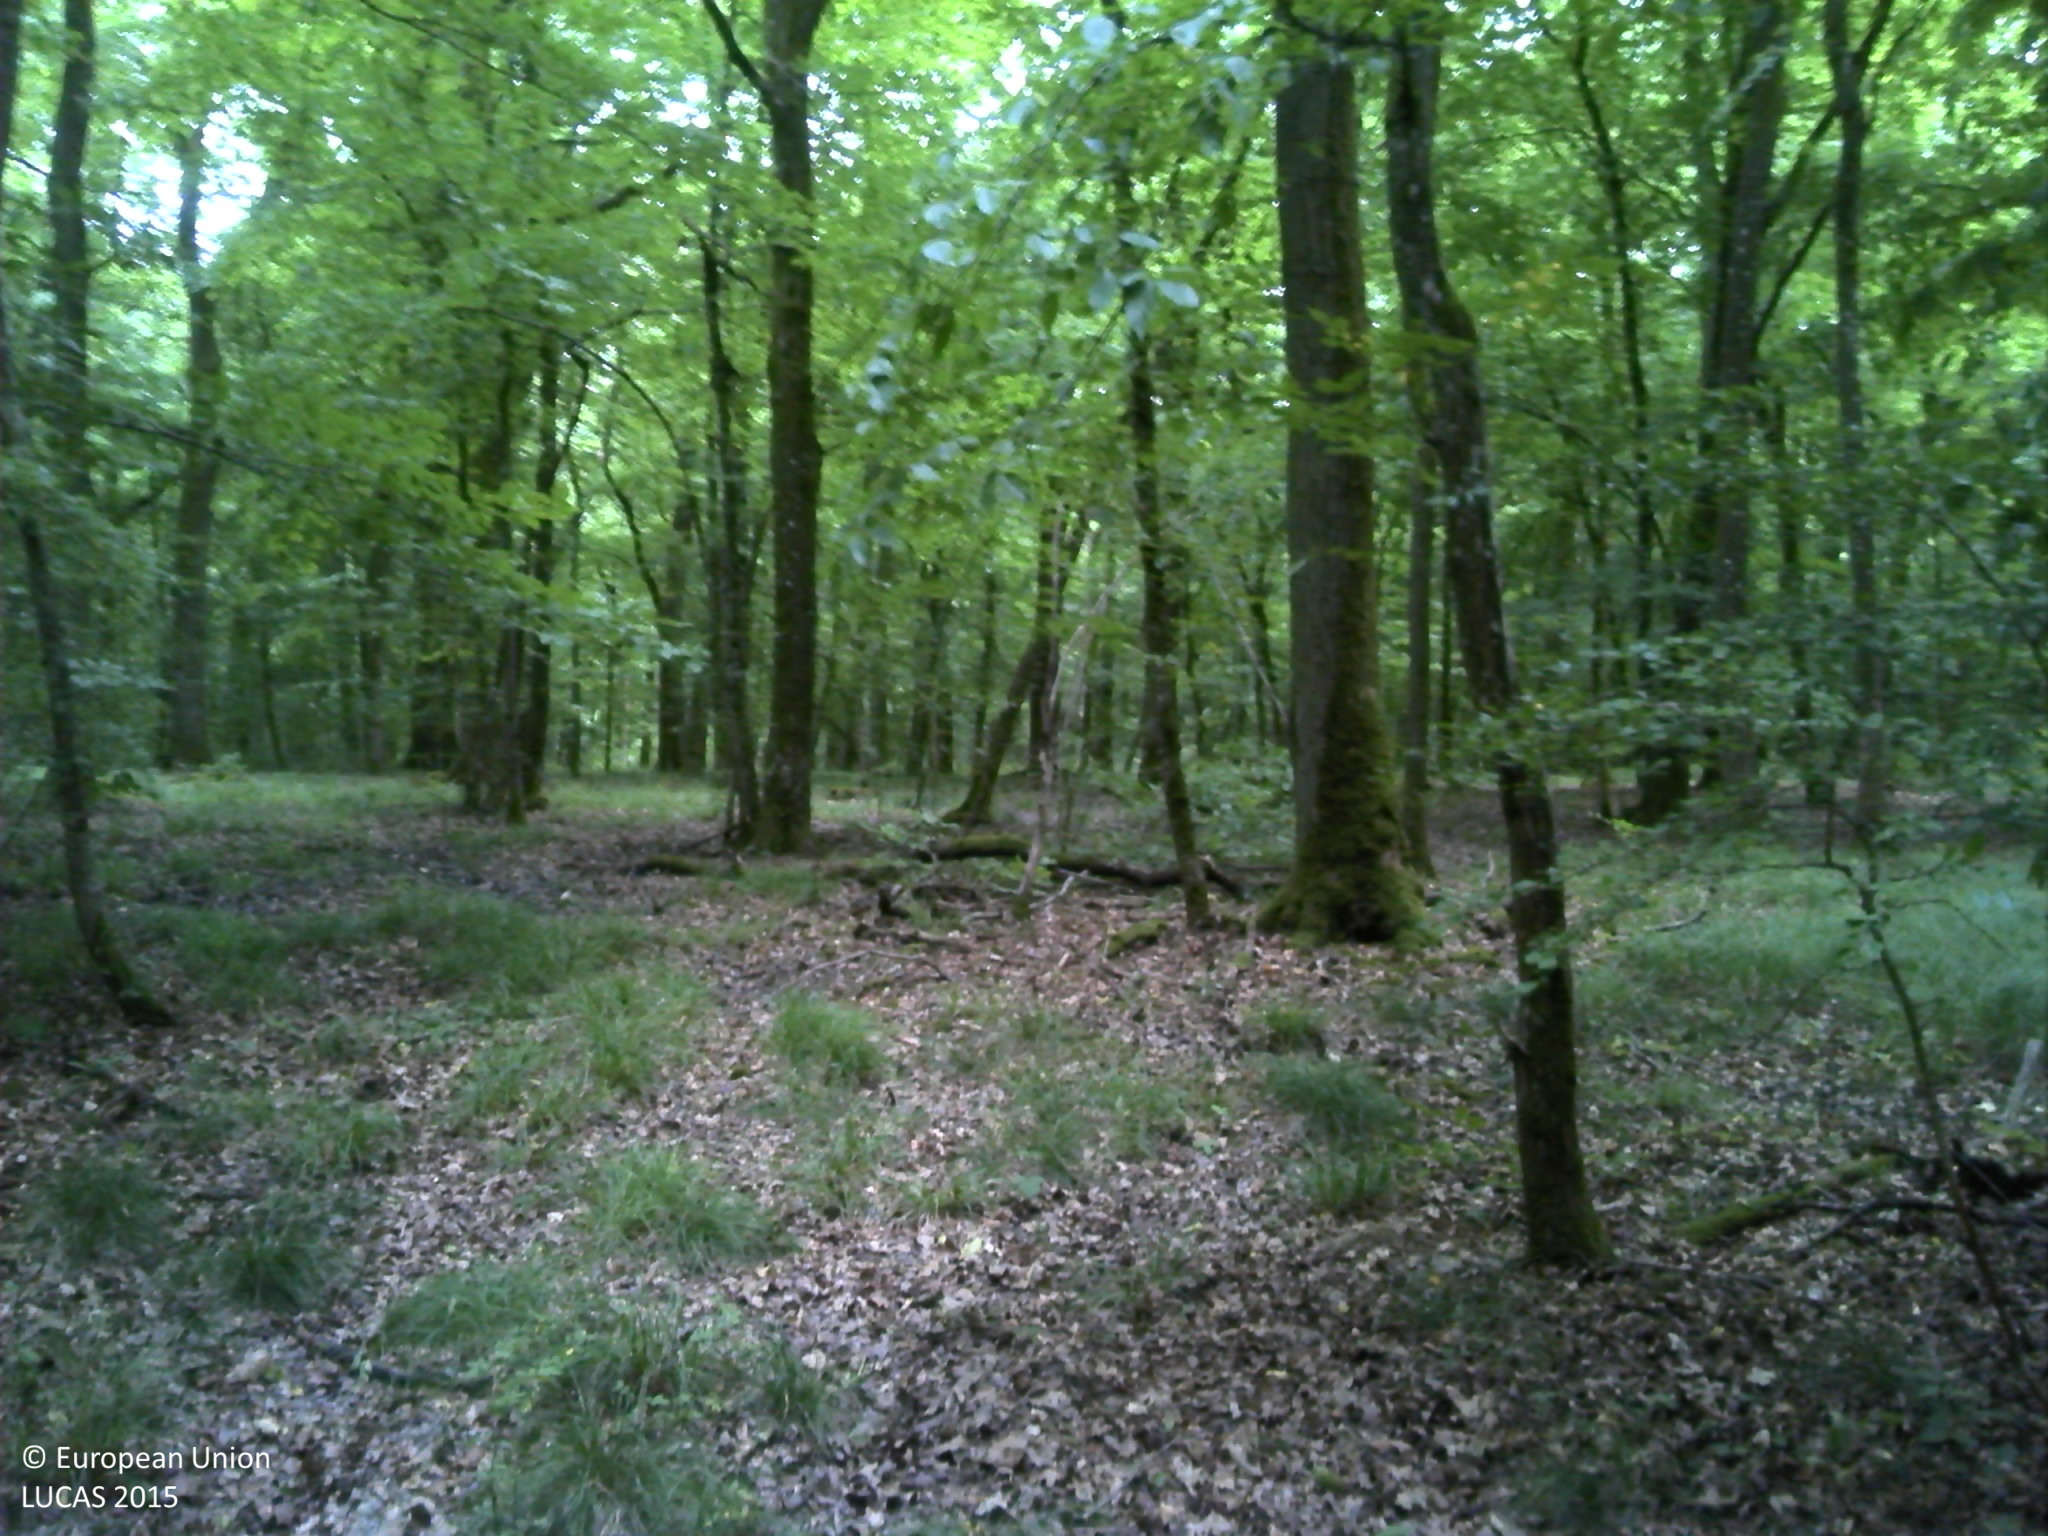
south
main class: Woodland
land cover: Broadleaved woodland
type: mesophytic deciduous forest
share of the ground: > 75 %
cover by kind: broadleaved forest trees 100 %
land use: Forestry
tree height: > 5 m
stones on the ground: < 10 %
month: July
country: FR
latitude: 49.3194
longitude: 6.4643
